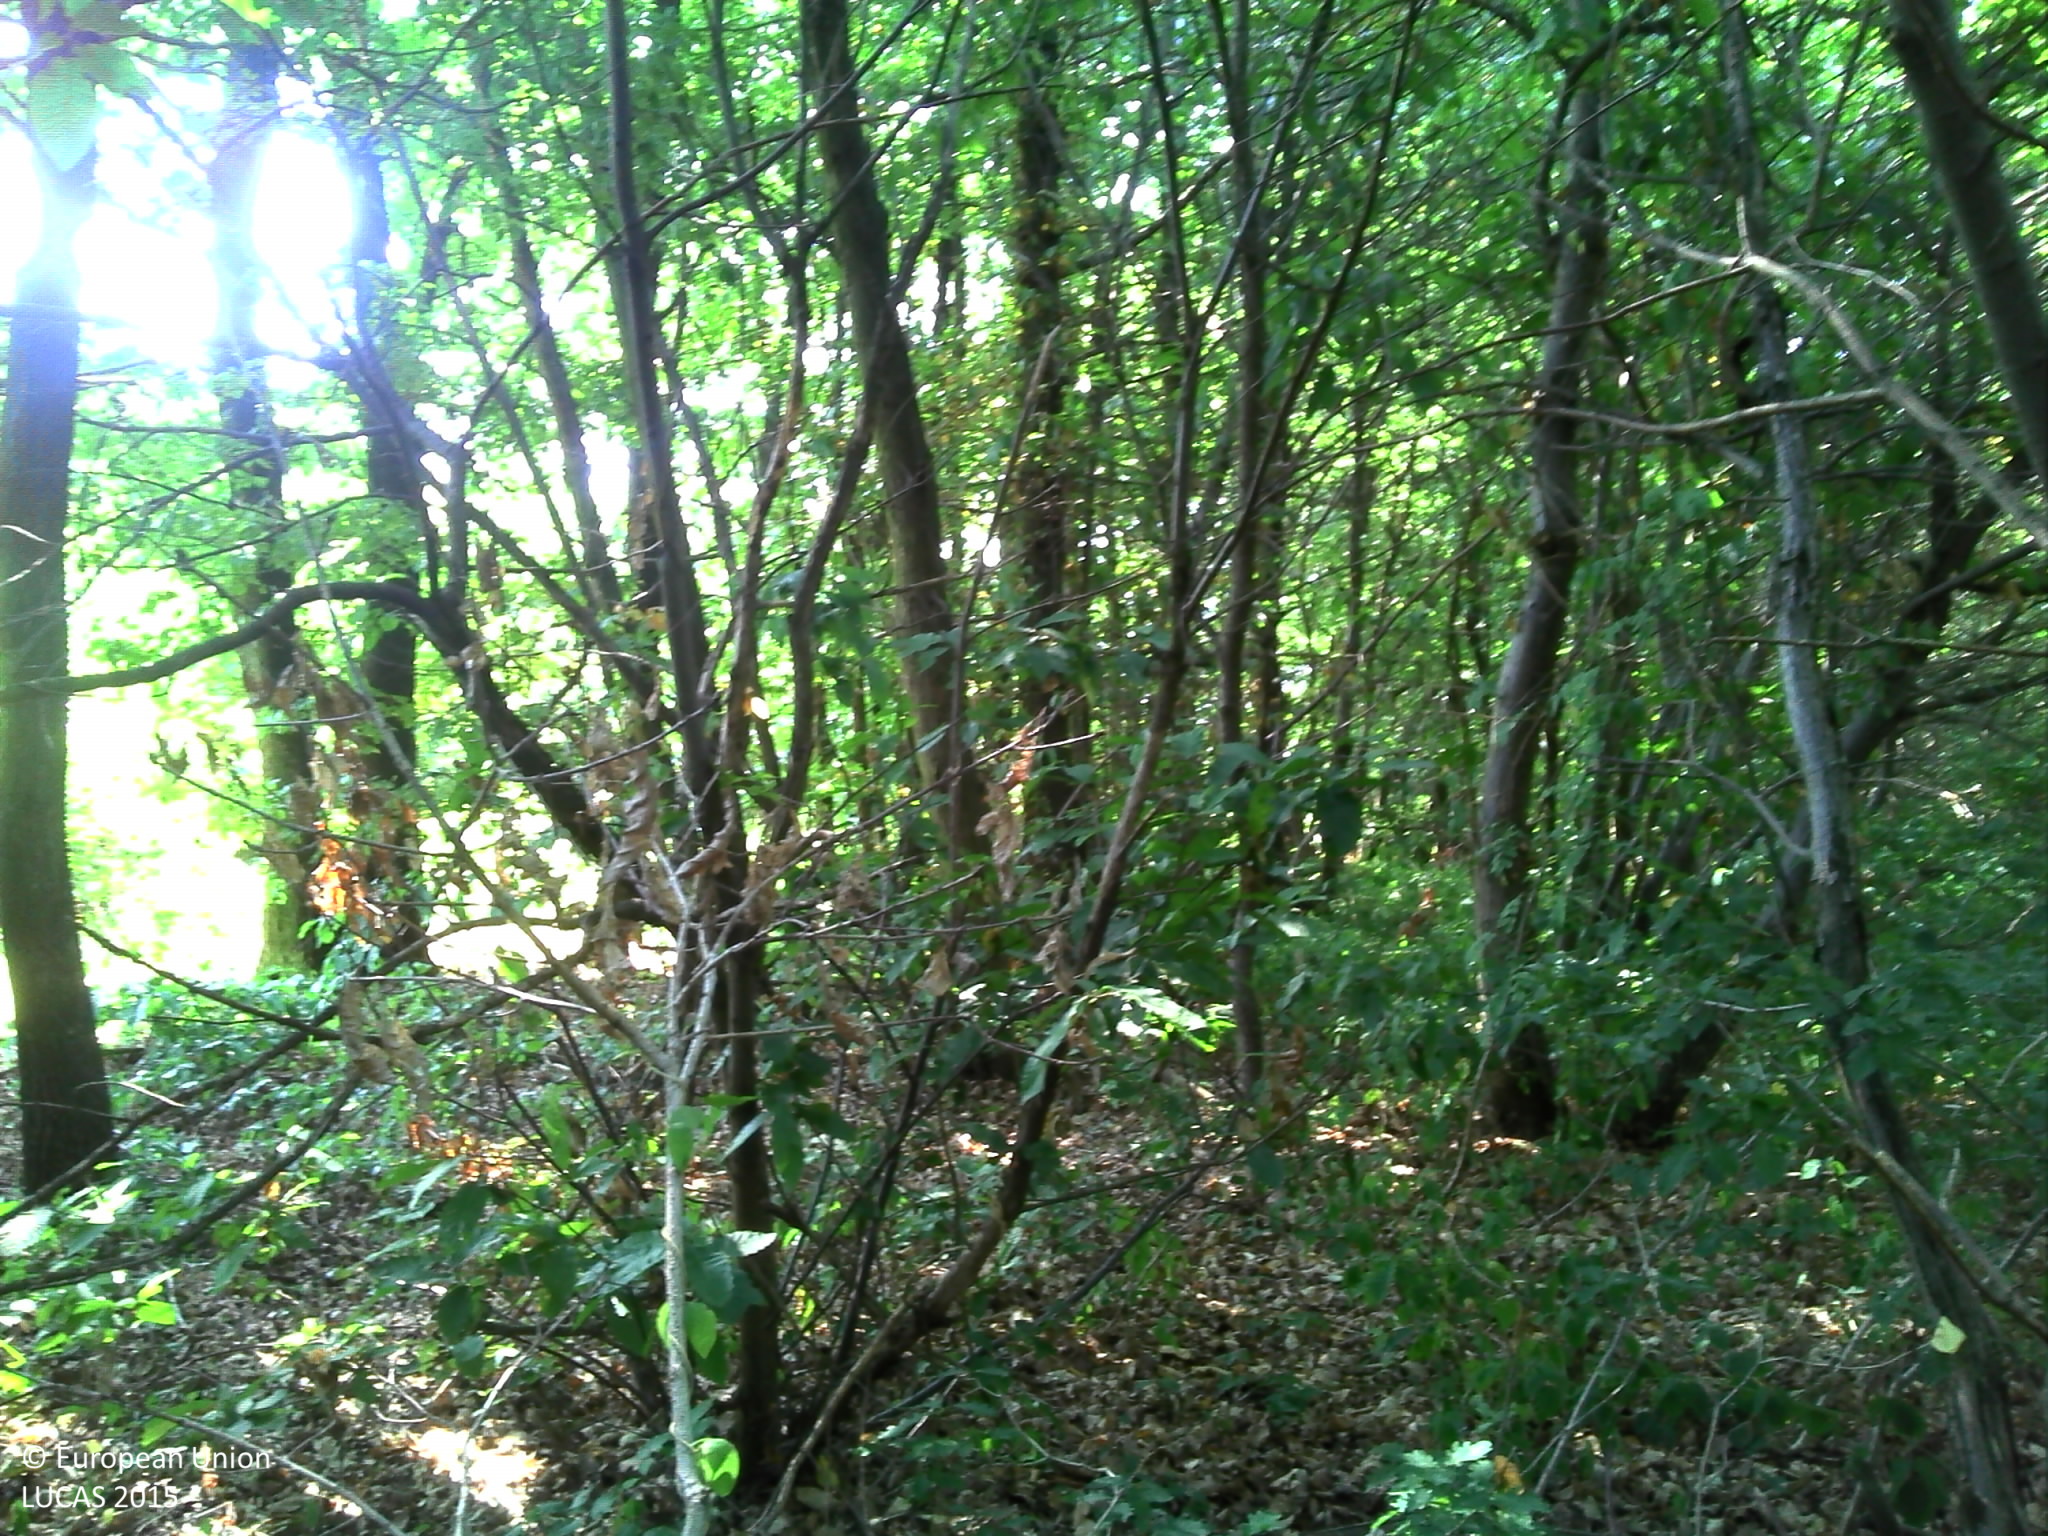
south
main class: Woodland
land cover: Broadleaved woodland
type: mesophytic deciduous forest
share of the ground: > 75 %
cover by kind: broadleaved forest trees 90 %, herbaceous plants 5 %, consolidated bare surface 5 %
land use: Forestry
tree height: > 5 m
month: July
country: FR
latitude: 45.3984
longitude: 4.8819
